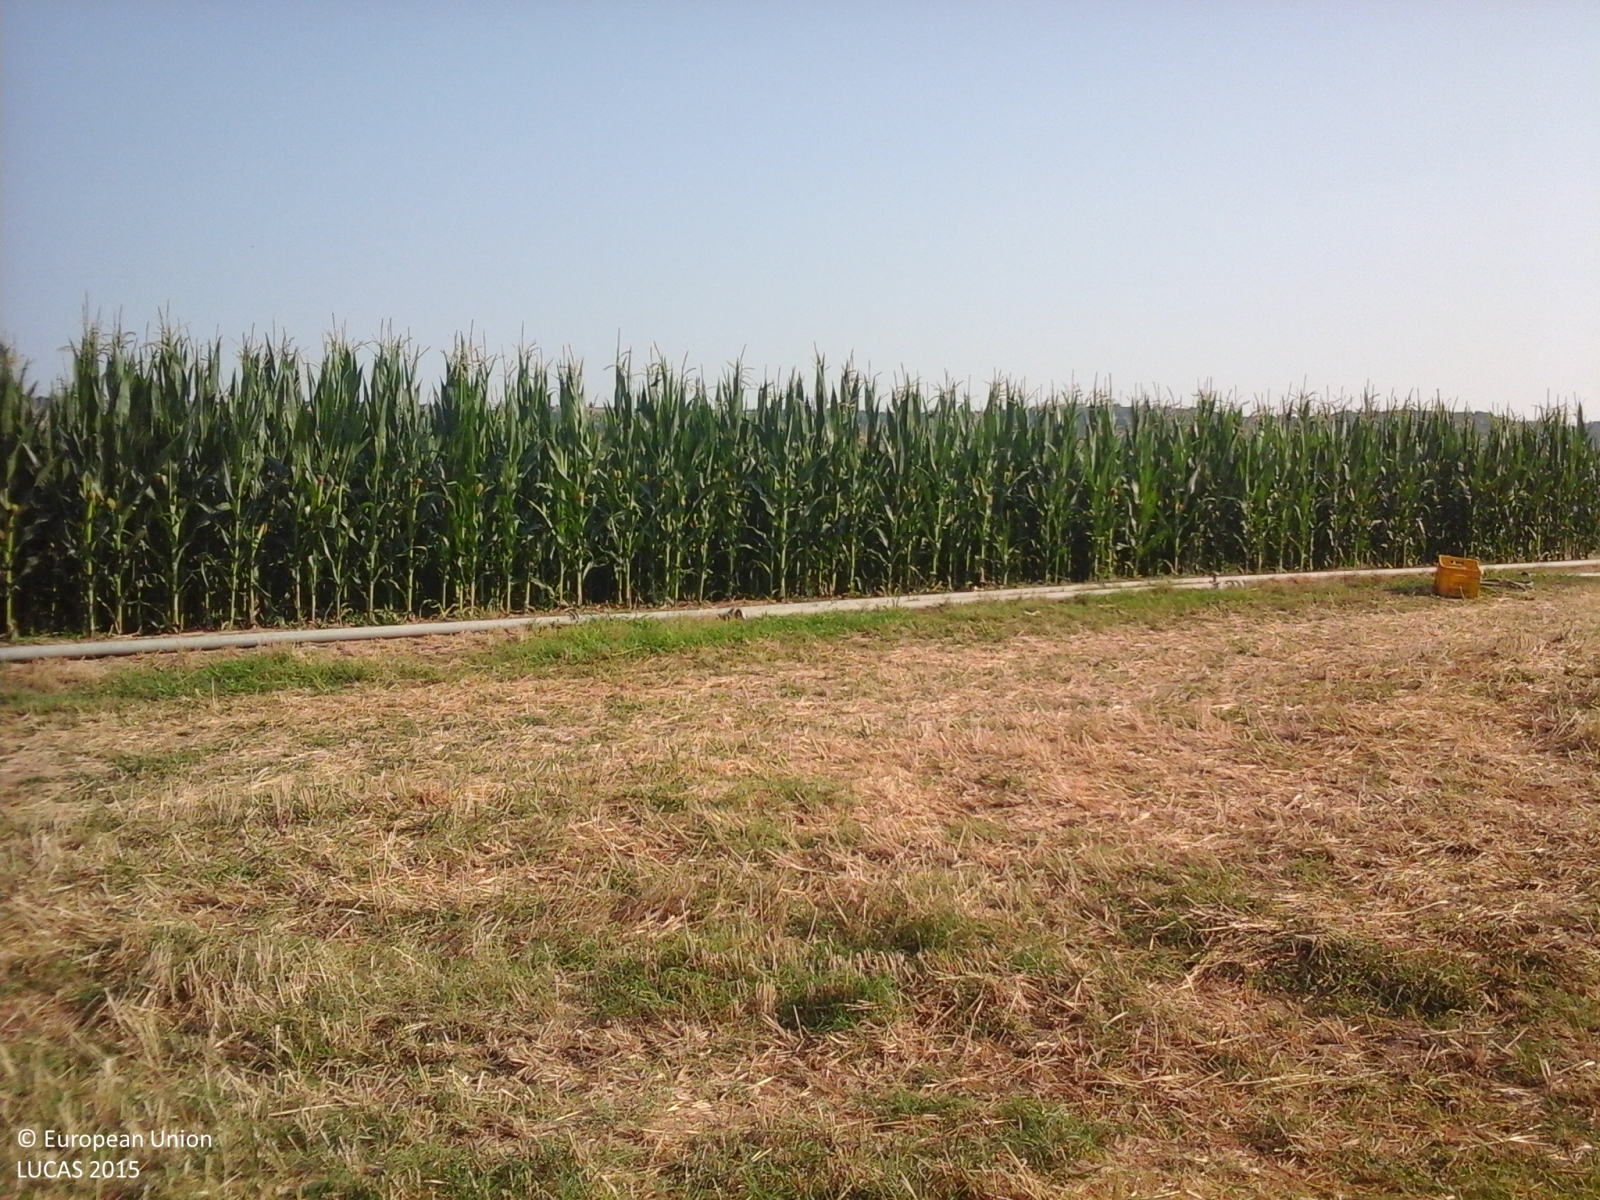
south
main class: Cropland
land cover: Vineyards
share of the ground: 50 - 75 %
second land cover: Grassland without tree/shrub cover
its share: > 75 %
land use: Agriculture (excluding fallow land and kitchen gardens)
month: July
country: IT
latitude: 43.0894
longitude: 13.7860
